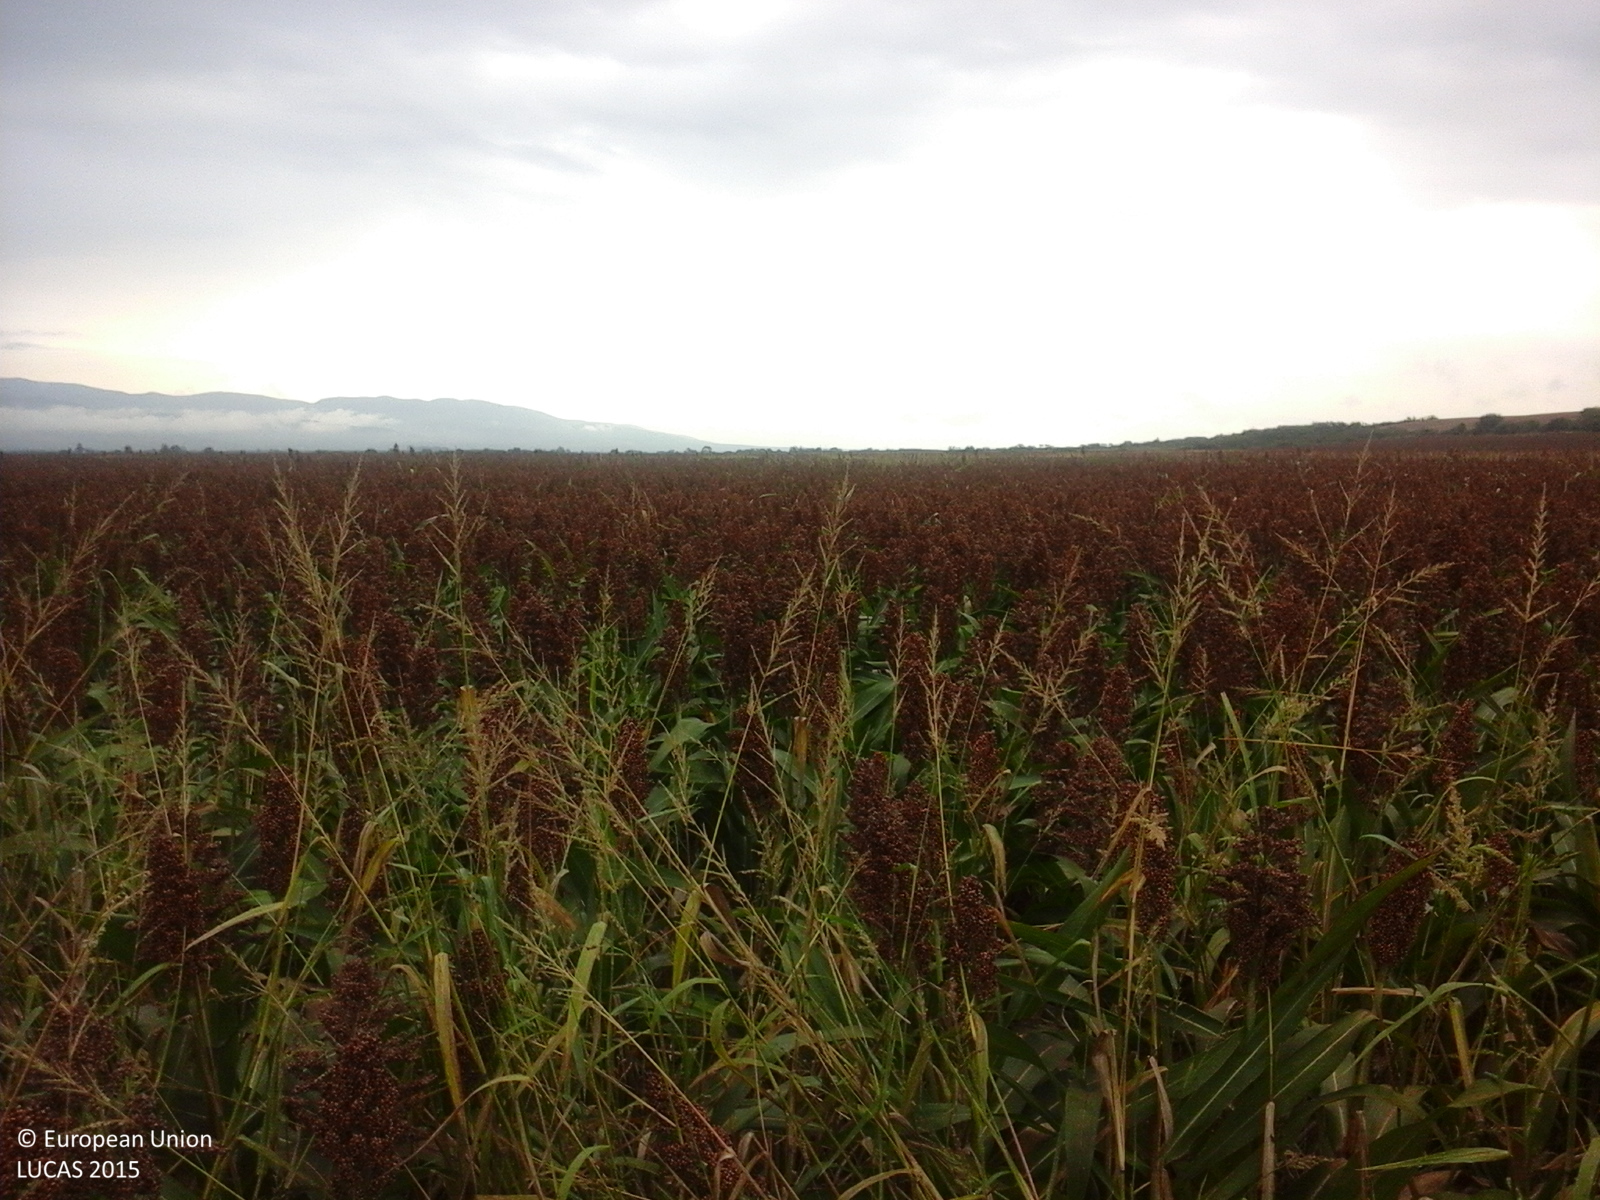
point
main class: Cropland
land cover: Other cereals
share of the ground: > 75 %
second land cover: Spontaneously vegetated surfaces
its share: 25 - 50 %
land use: Agriculture (excluding fallow land and kitchen gardens)
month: September
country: RO
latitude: 45.5942
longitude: 22.0512
